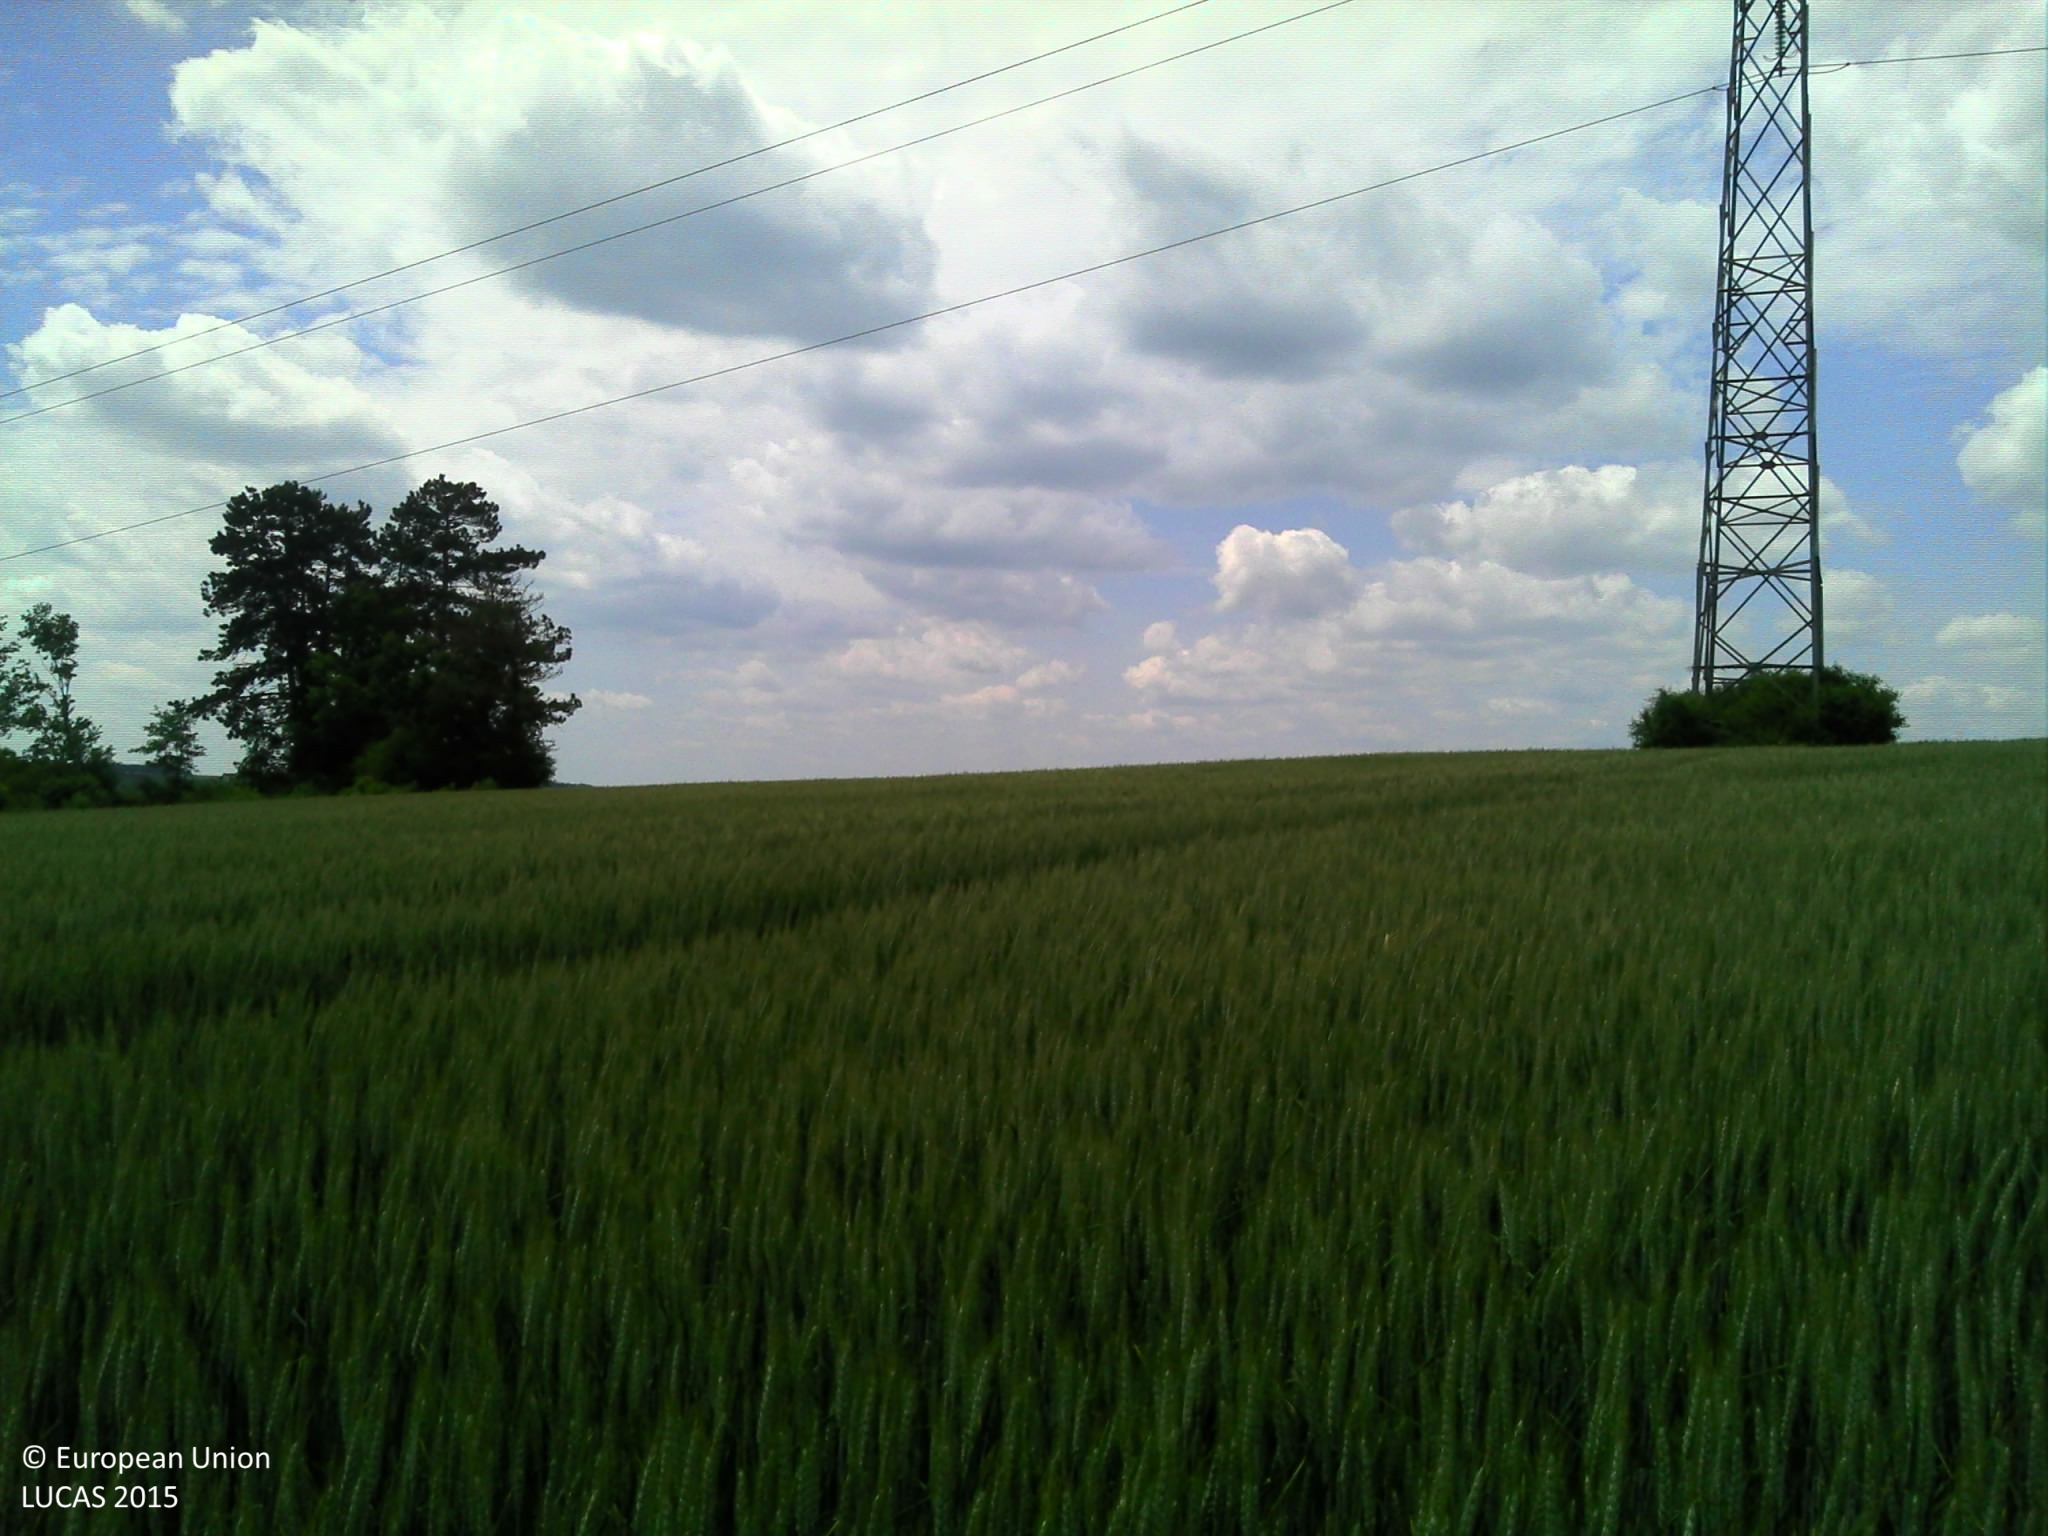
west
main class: Cropland
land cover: Common wheat
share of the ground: > 75 %
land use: Agriculture (excluding fallow land and kitchen gardens)
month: May
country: FR
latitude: 47.7494
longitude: 3.9281
